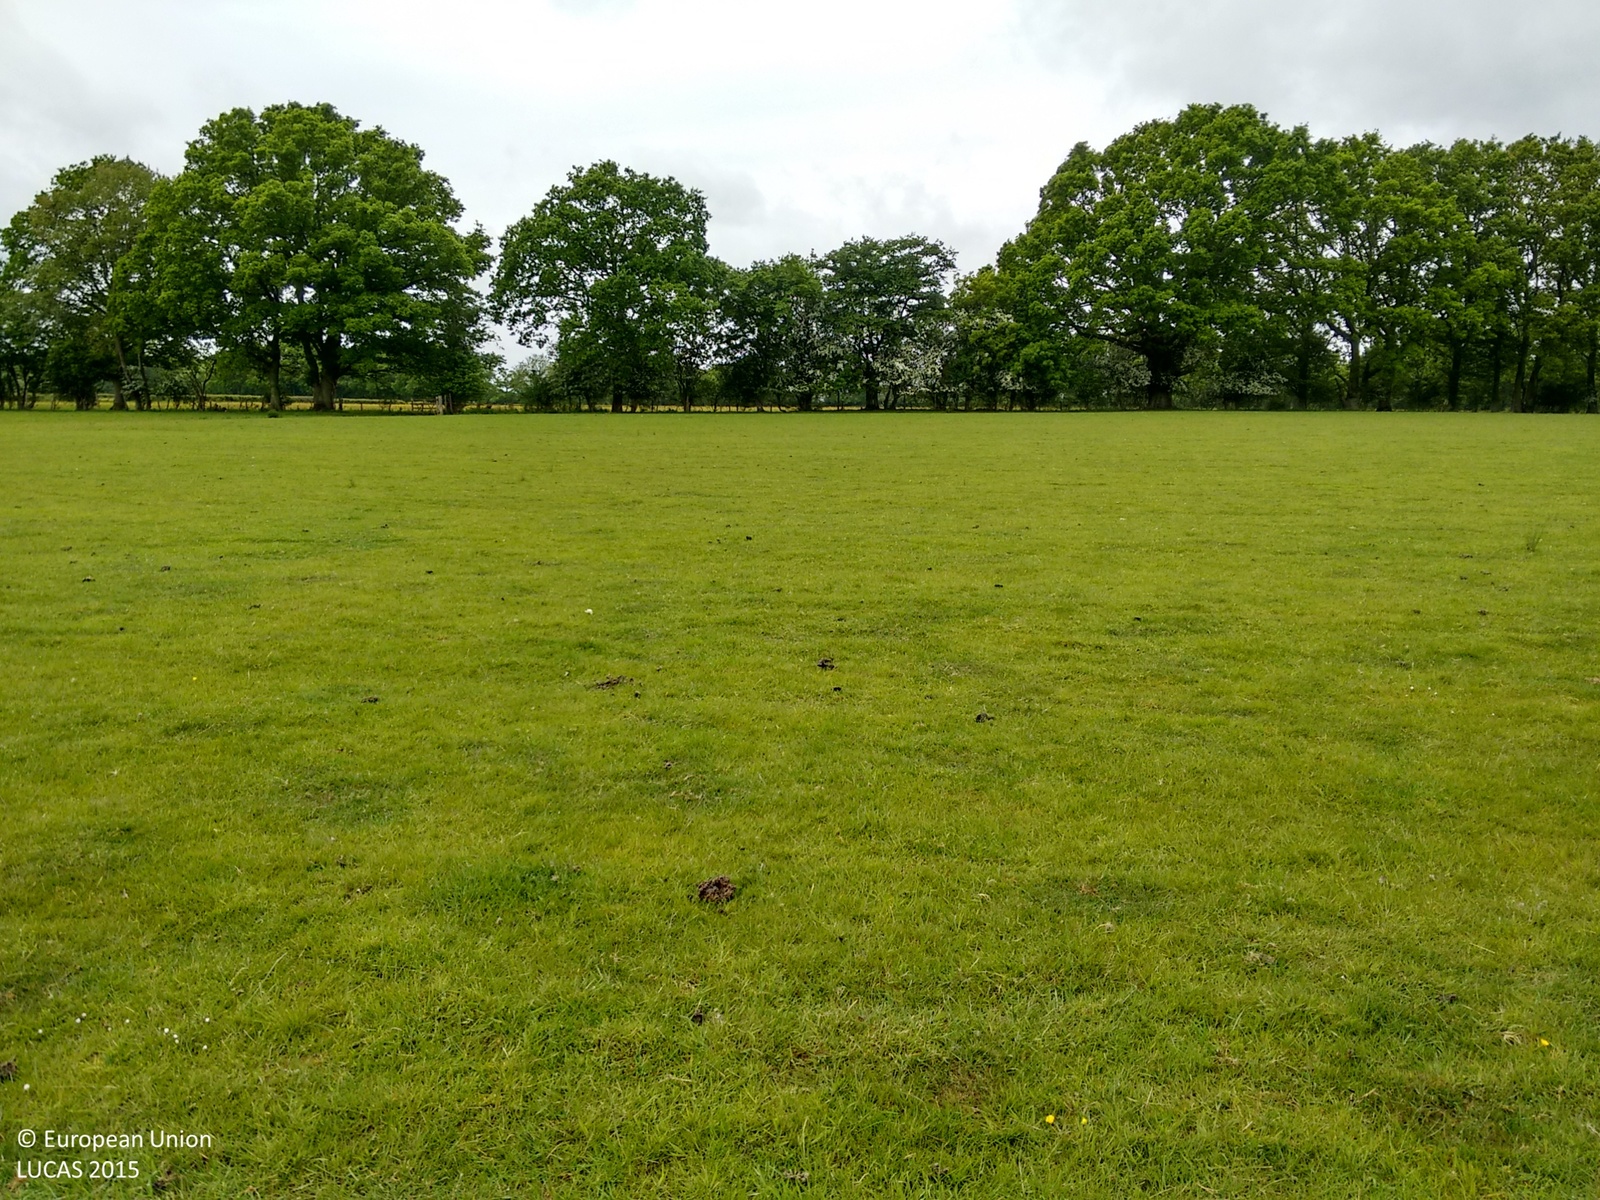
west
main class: Grassland
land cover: Grassland without tree/shrub cover
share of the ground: > 75 %
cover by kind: herbaceous plants 100 %
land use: Agriculture (excluding fallow land and kitchen gardens)
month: May
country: GB
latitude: 51.1938
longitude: 0.6581
